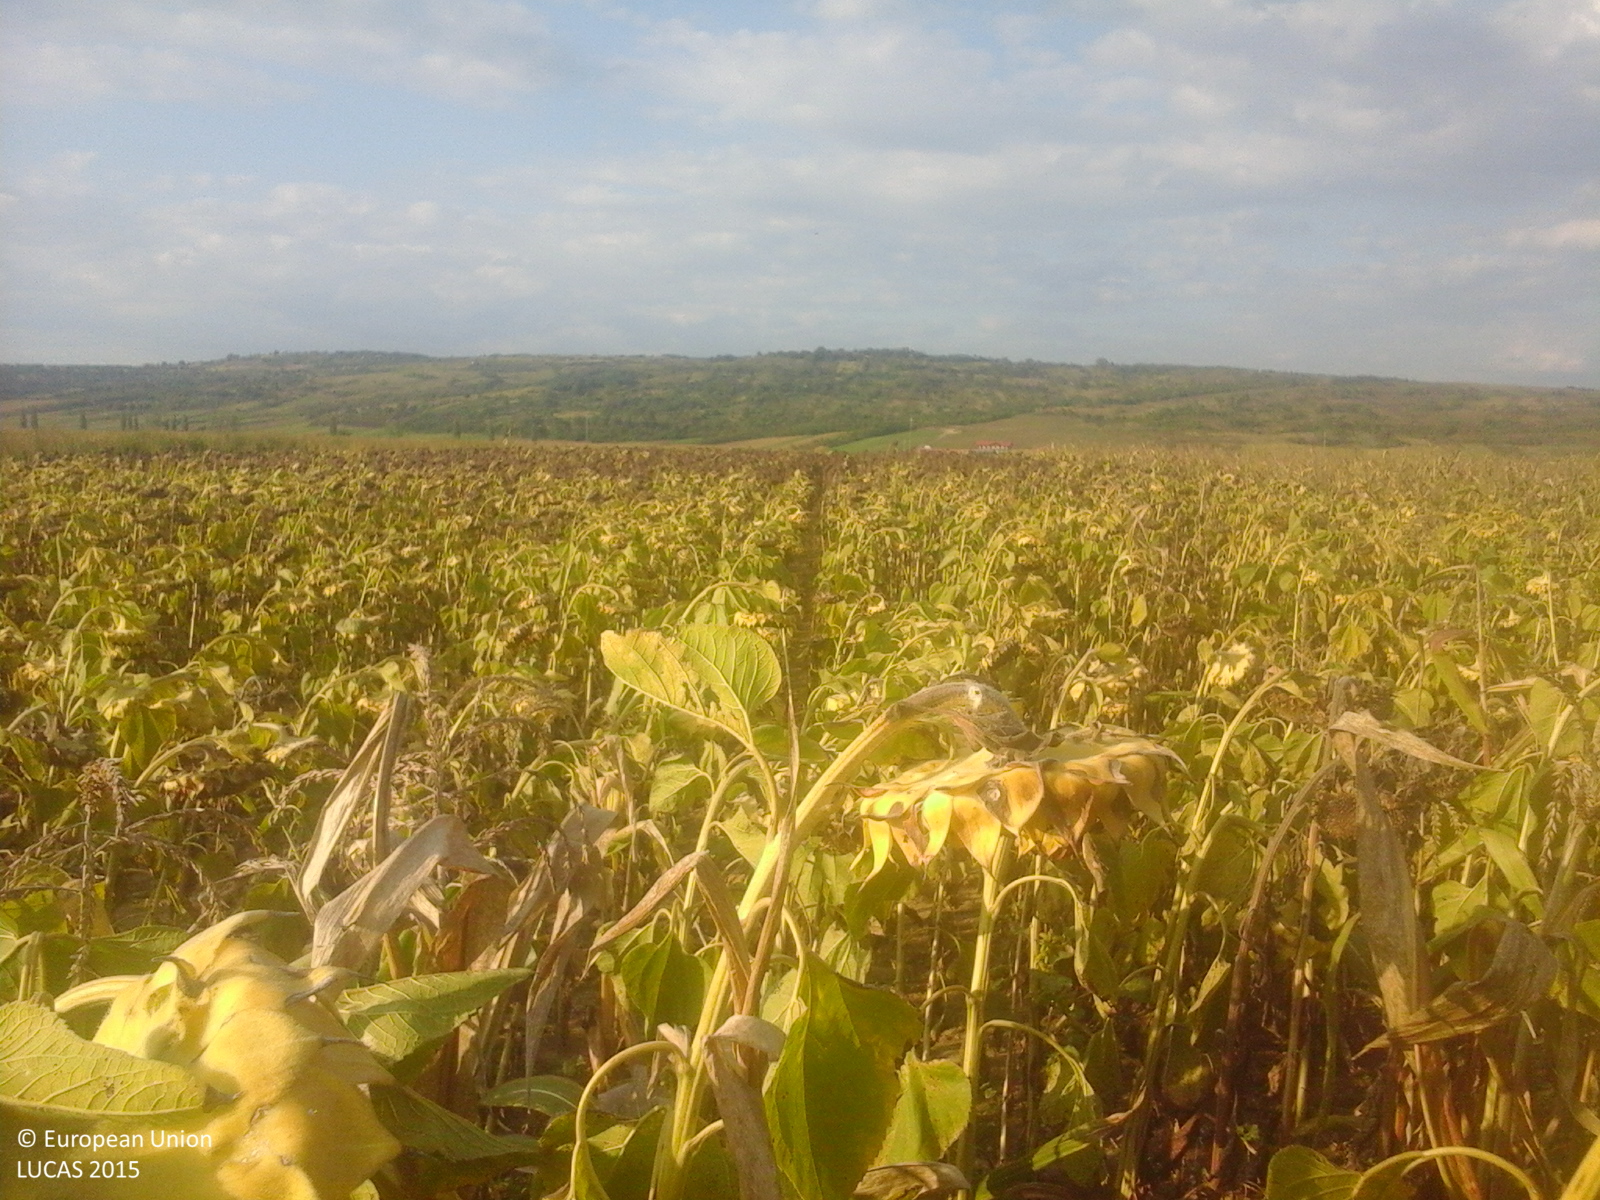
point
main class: Cropland
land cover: Sunflower
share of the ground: > 75 %
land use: Agriculture (excluding fallow land and kitchen gardens)
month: September
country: RO
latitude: 47.3213
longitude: 22.8556
